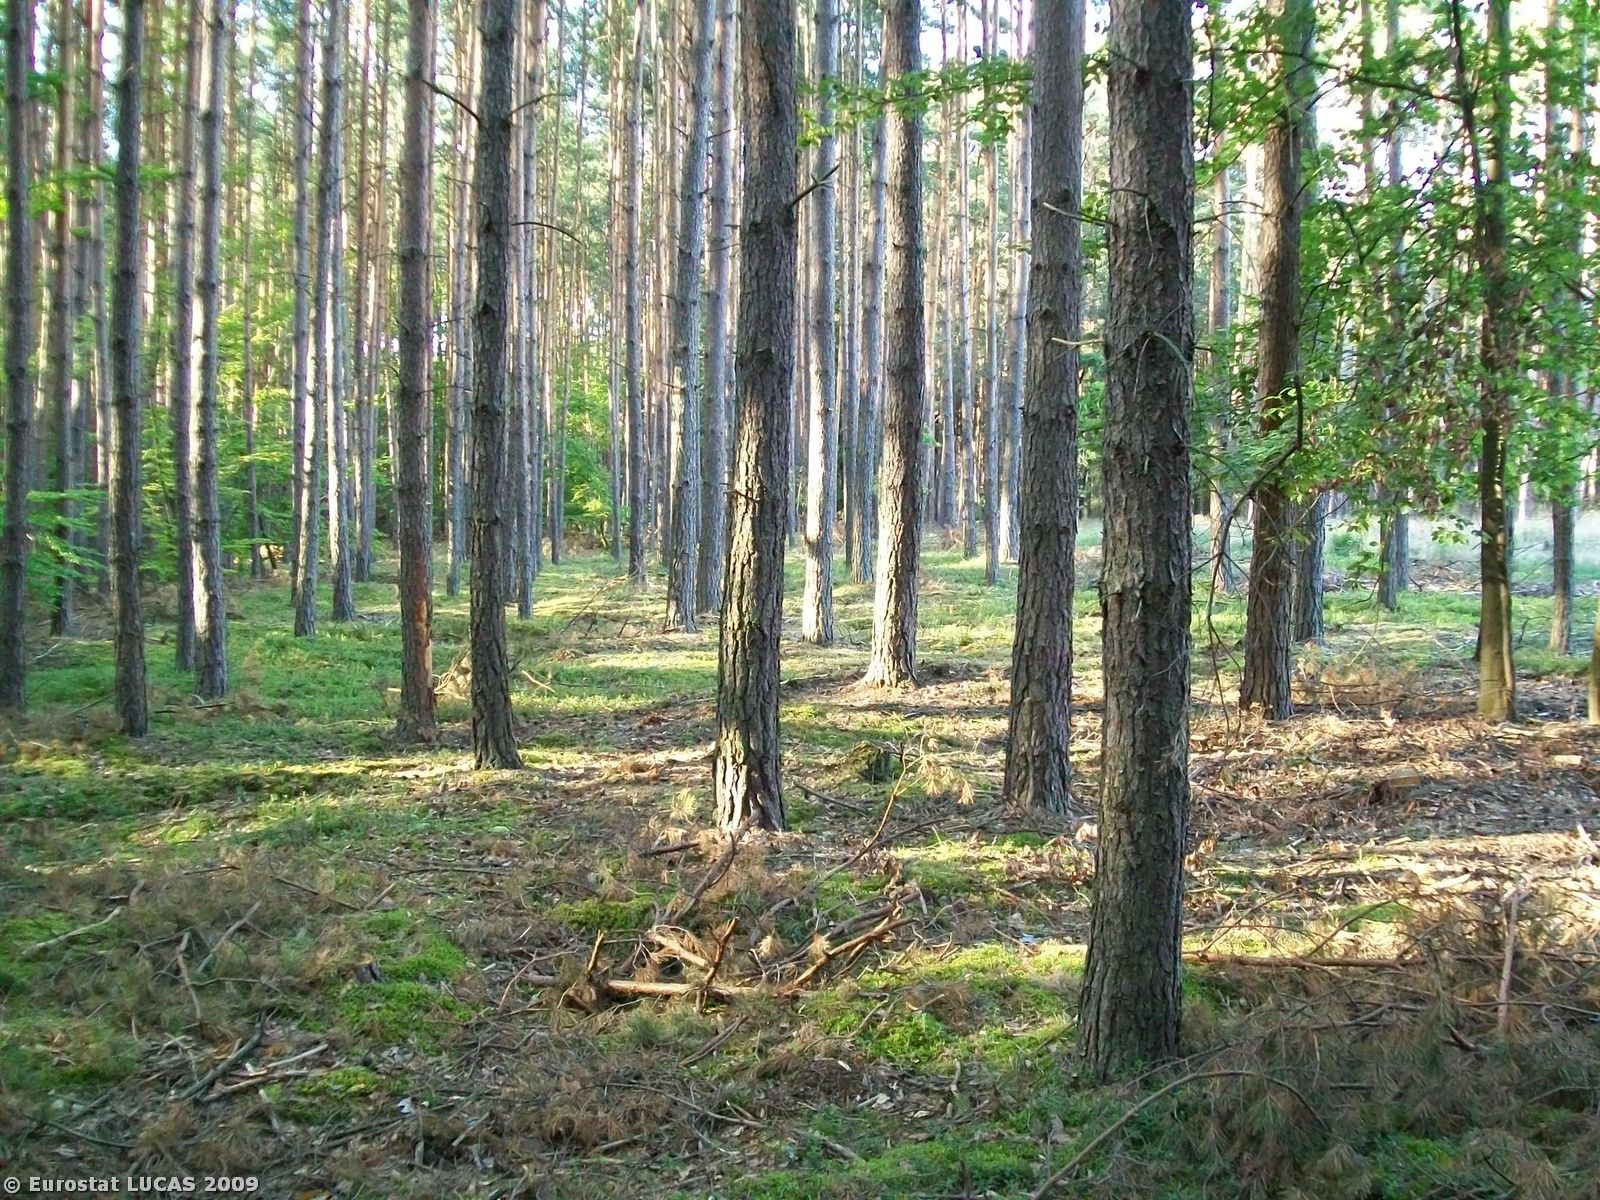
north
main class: Woodland
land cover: Mixed woodland
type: hemiboreal forest and nemoral coniferous forest and mixed broadleaved-coniferous forest
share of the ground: > 75 %
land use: Forestry
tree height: > 5 m
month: August
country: PL
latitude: 51.0294
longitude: 17.6421
